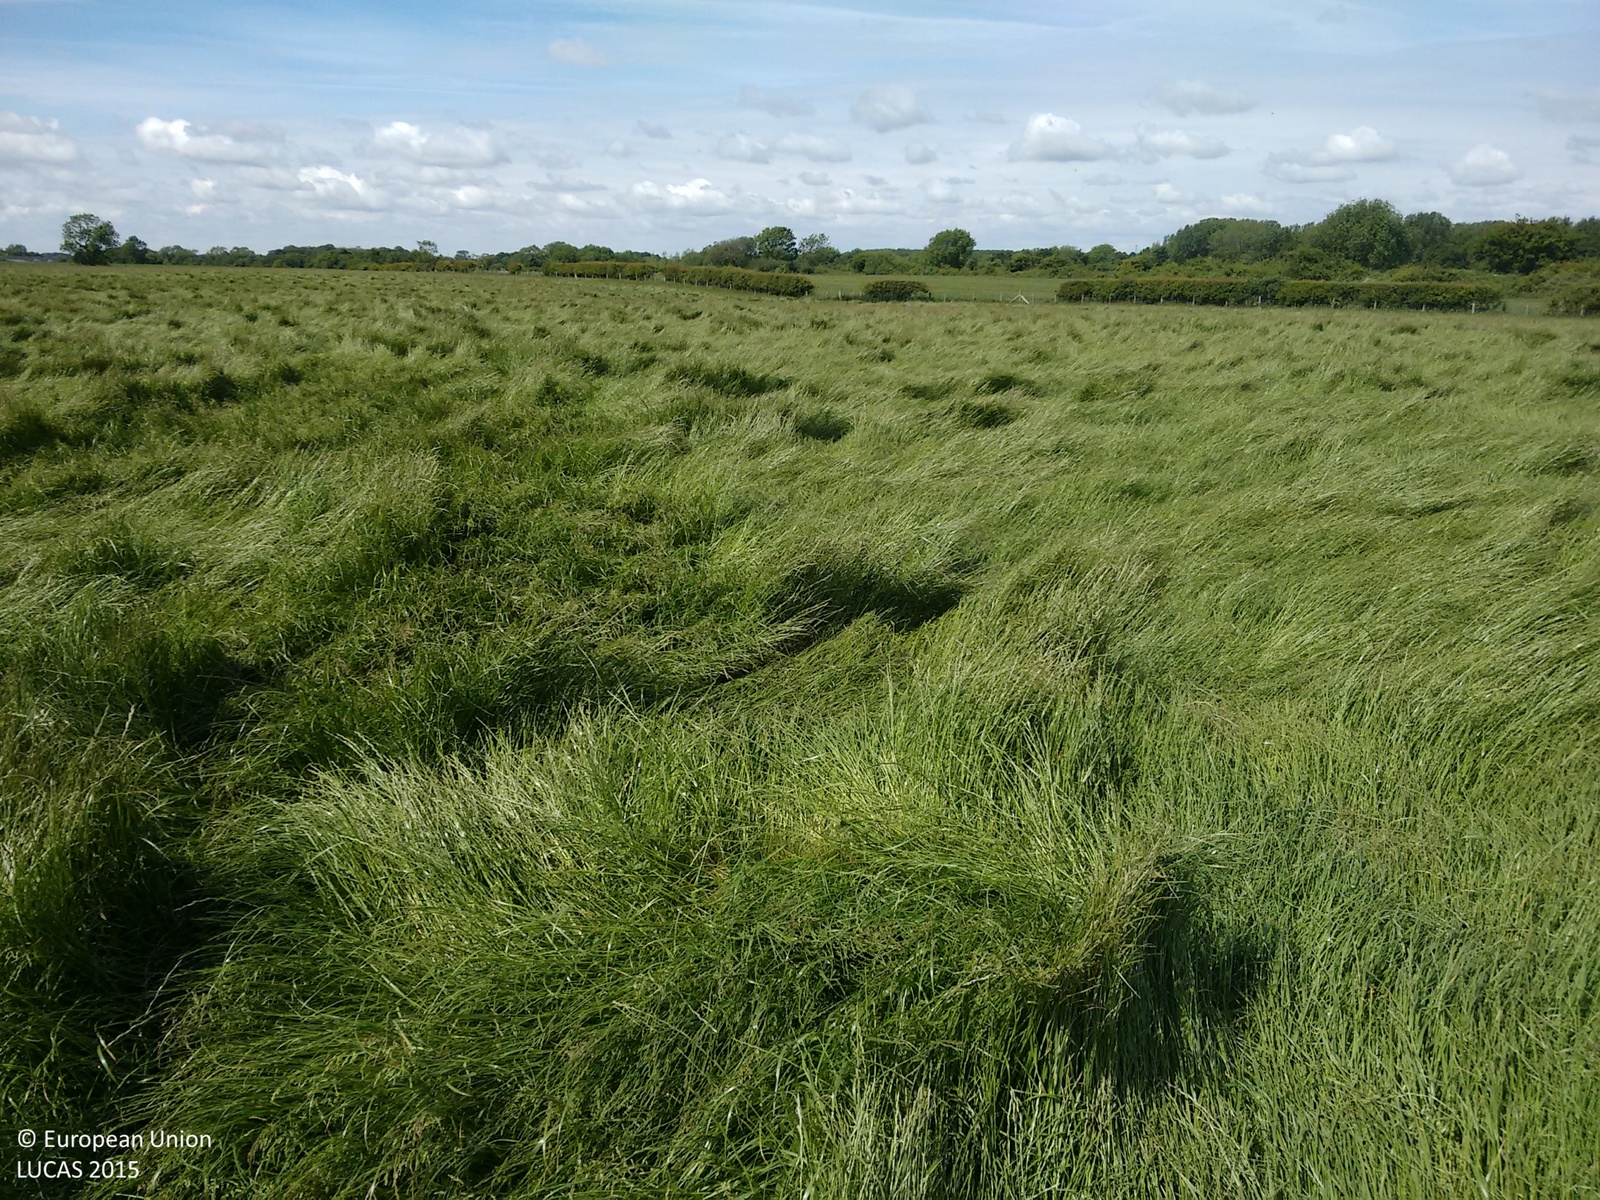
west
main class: Grassland
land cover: Grassland without tree/shrub cover
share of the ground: > 75 %
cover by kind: herbaceous plants 100 %
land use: Agriculture (excluding fallow land and kitchen gardens)
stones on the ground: < 10 %
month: June
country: GB
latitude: 54.4374
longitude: -1.2539
